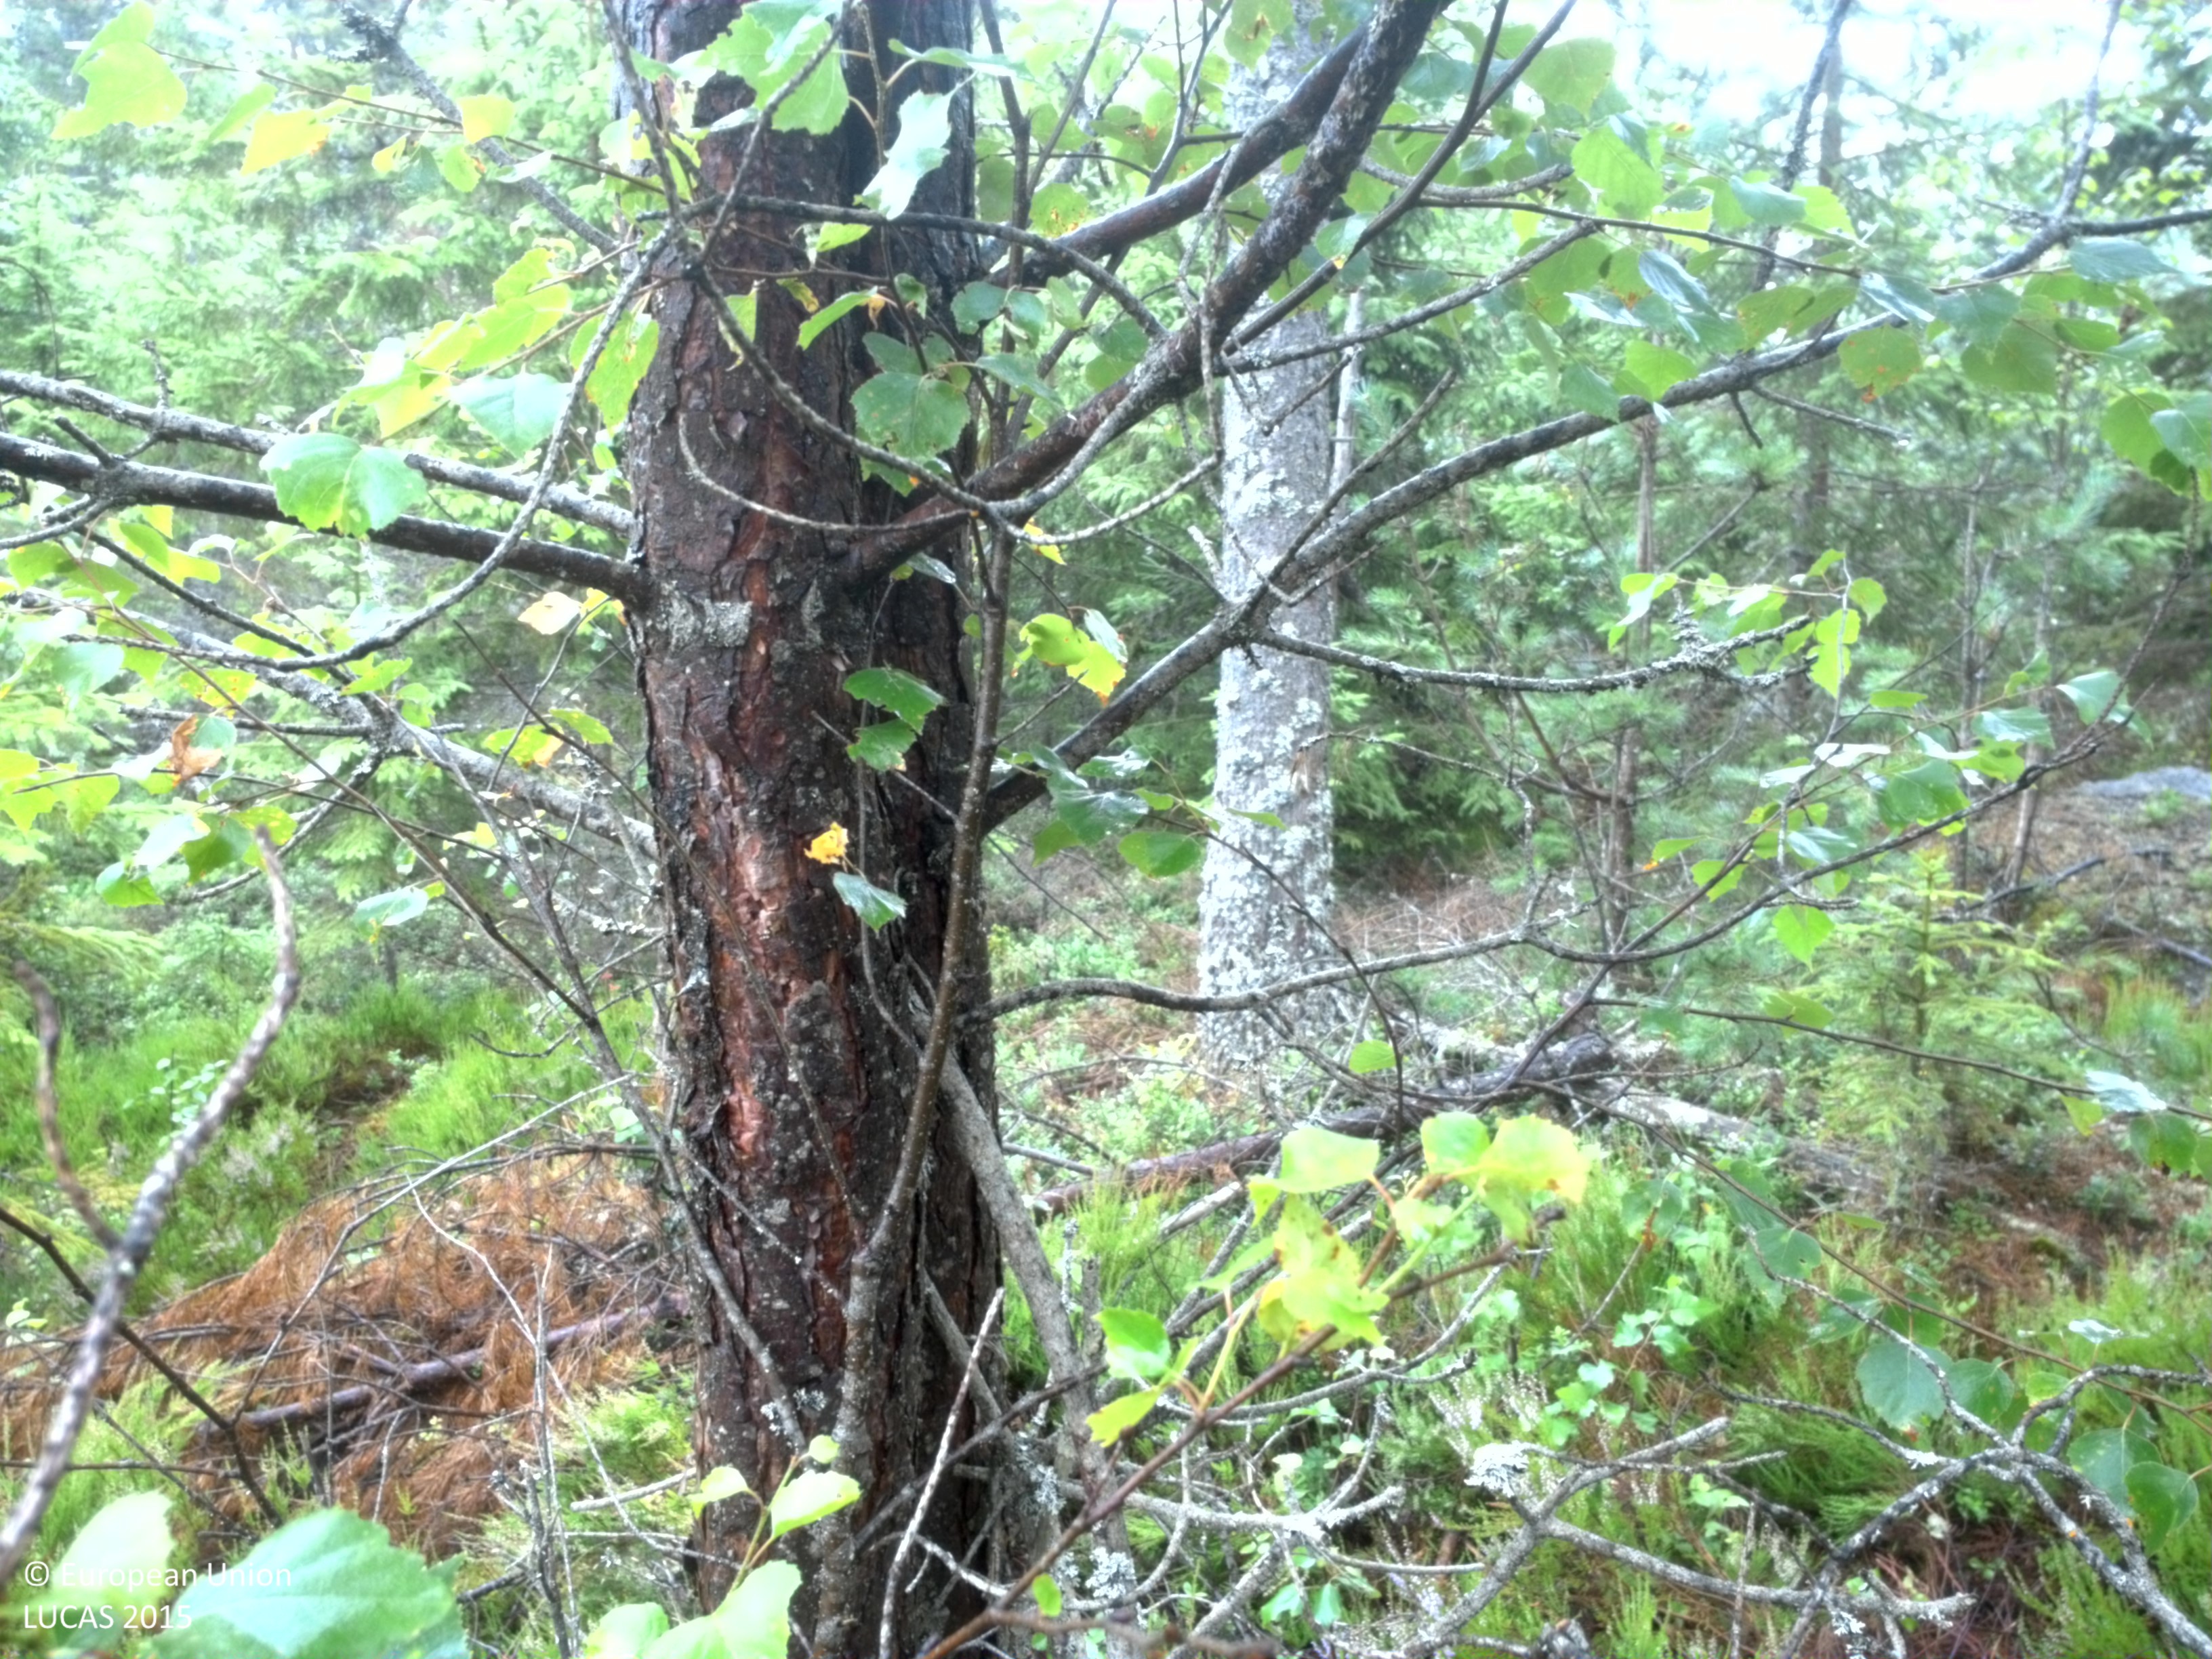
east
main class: Woodland
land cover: Other coniferous woodland
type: boreal forest
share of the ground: > 75 %
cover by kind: coniferous forest trees 70 %, broadleaved forest trees 10 %, shrubs 10 %, lichens and mosses 10 %
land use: Forestry
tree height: > 5 m
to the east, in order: Other coniferous woodland; Other mixed woodland; Pine dominated mixed woodland; Ditches and canals; Other mixed woodland; Spruce dominated mixed woodland
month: July
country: SE
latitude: 59.2558
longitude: 14.6741
